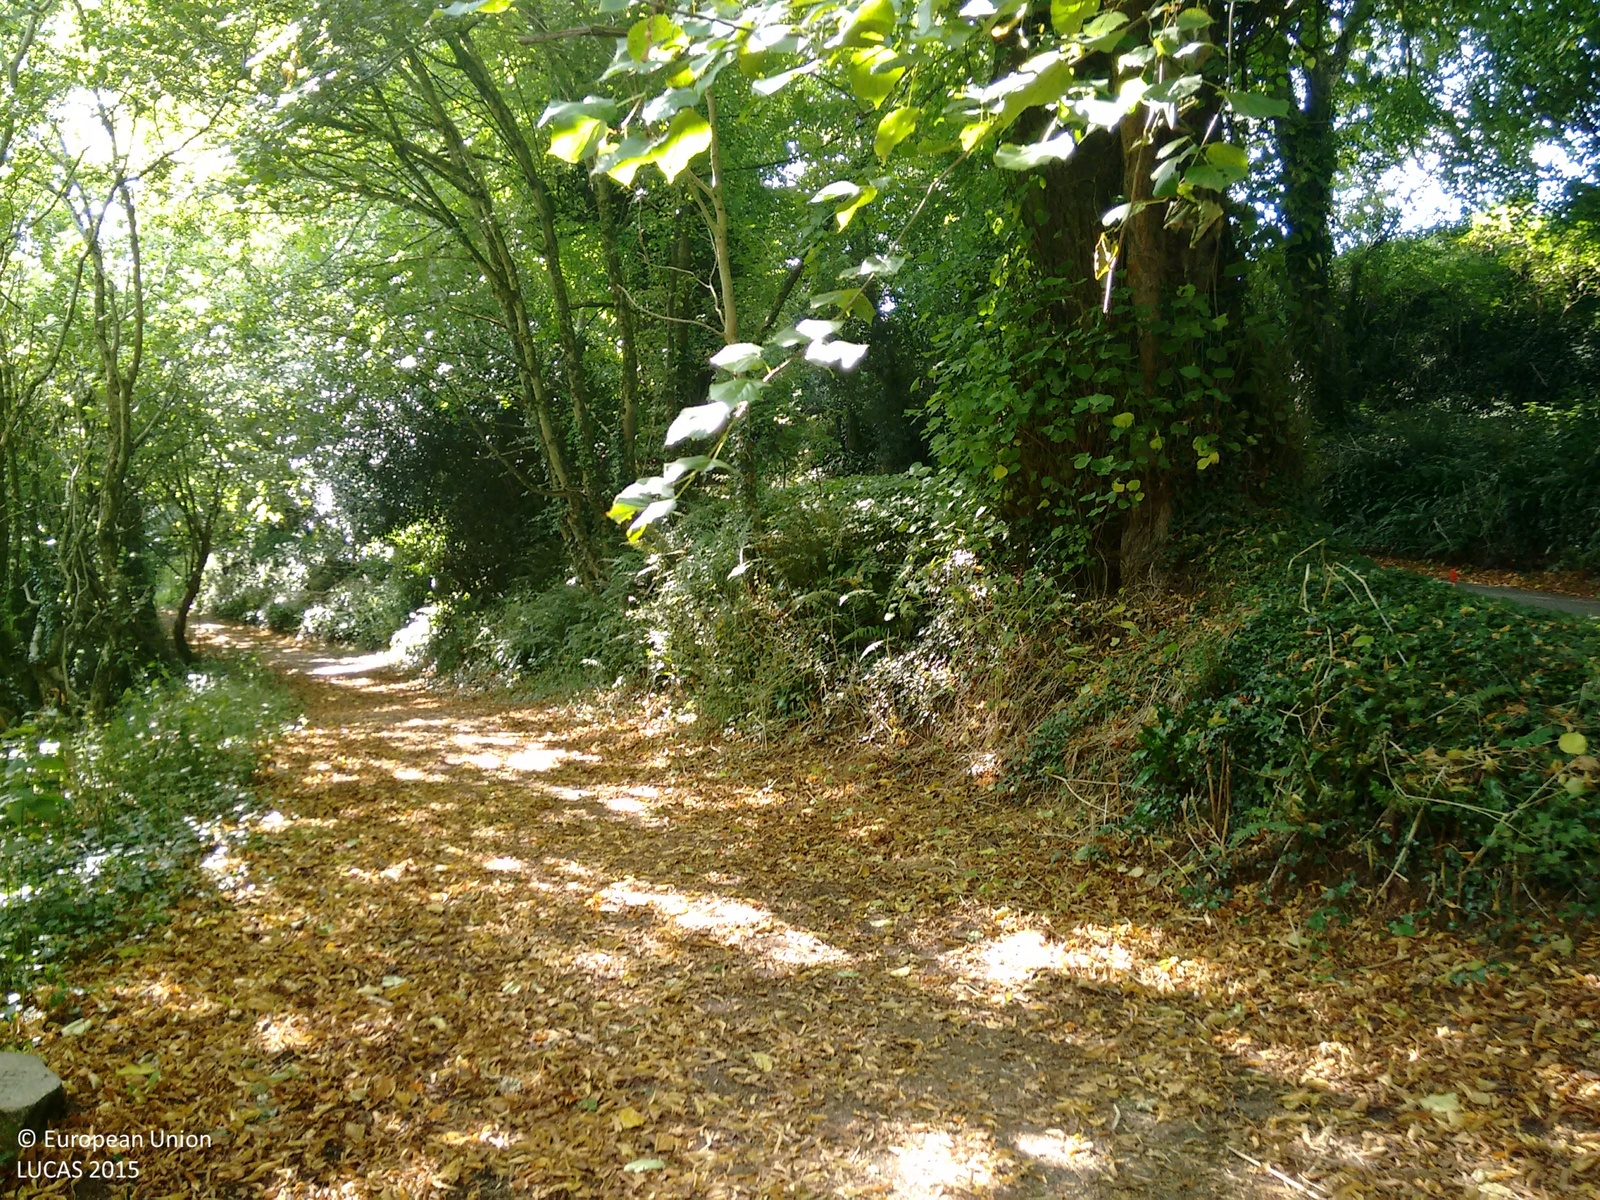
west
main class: Woodland
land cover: Broadleaved woodland
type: mesophytic deciduous forest
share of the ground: > 75 %
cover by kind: broadleaved forest trees 100 %
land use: Semi-natural and natural areas not in use
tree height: > 5 m
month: September
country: GB
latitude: 50.9580
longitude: -4.1491
